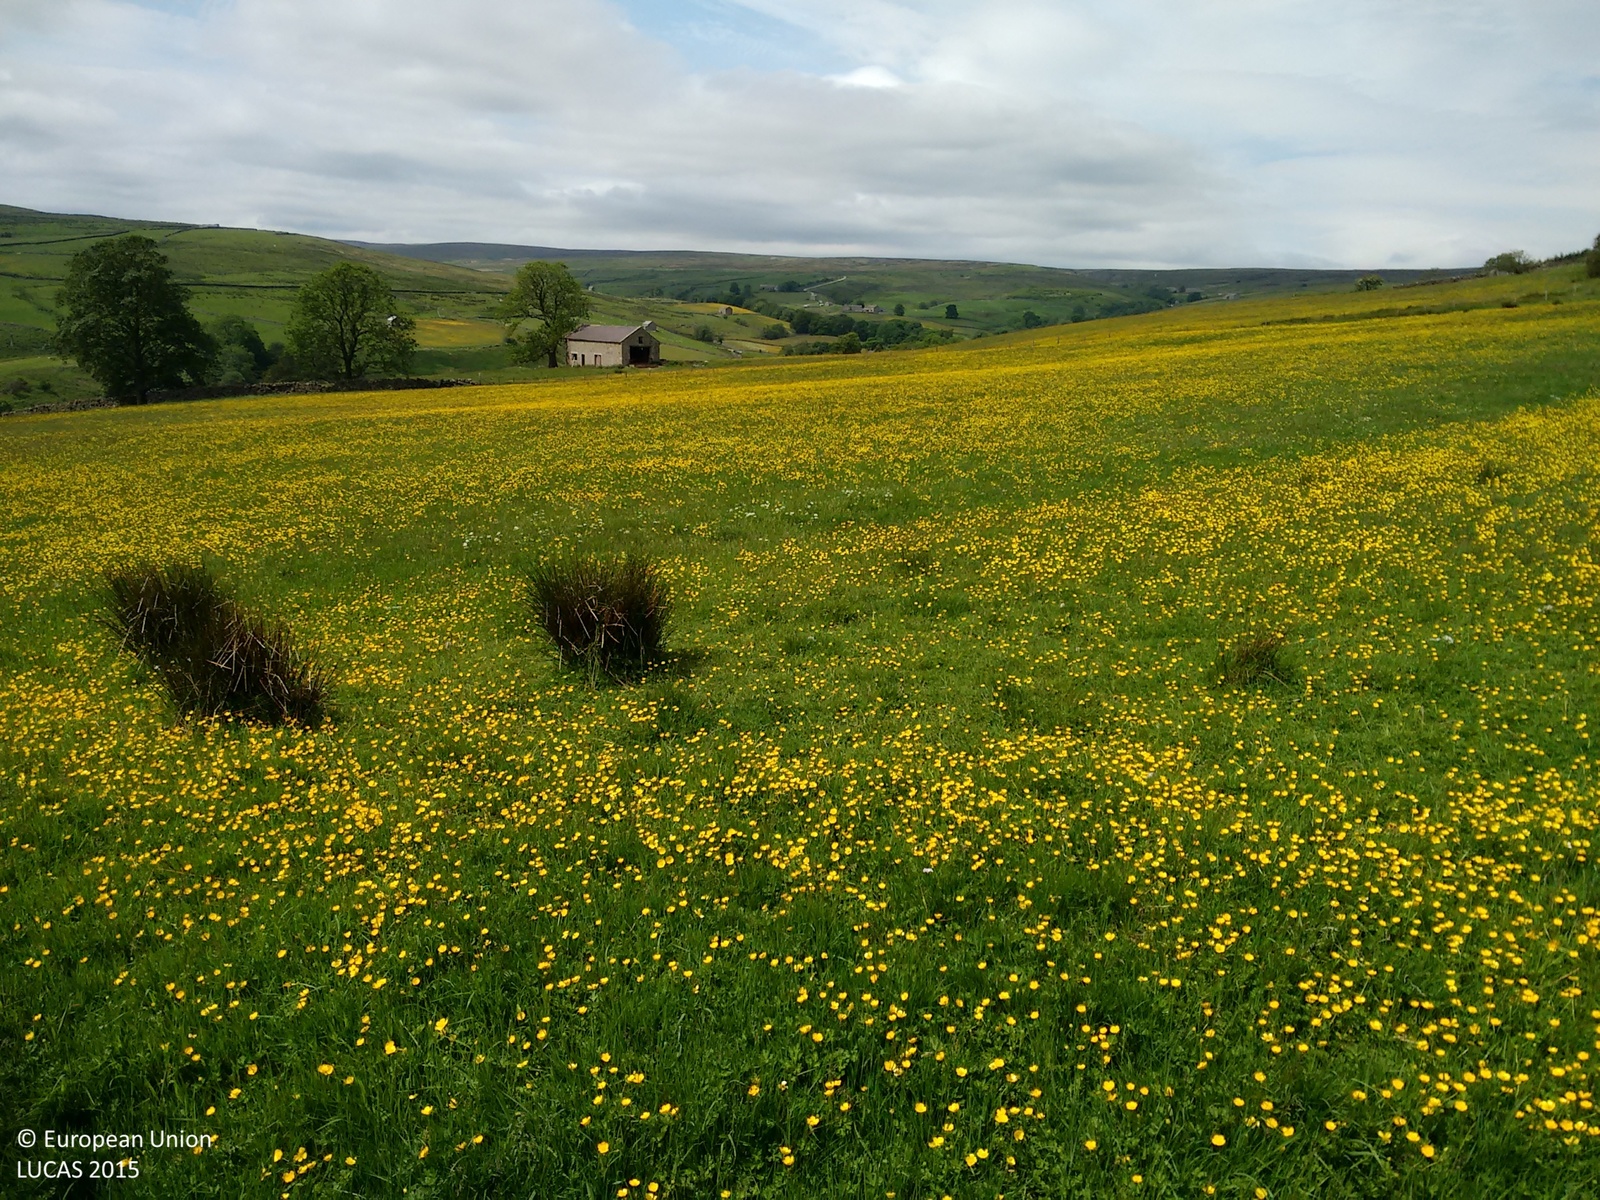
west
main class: Grassland
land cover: Grassland without tree/shrub cover
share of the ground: > 75 %
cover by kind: herbaceous plants 100 %
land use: Agriculture (excluding fallow land and kitchen gardens)
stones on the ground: < 10 %
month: June
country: GB
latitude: 54.1619
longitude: -1.8623
